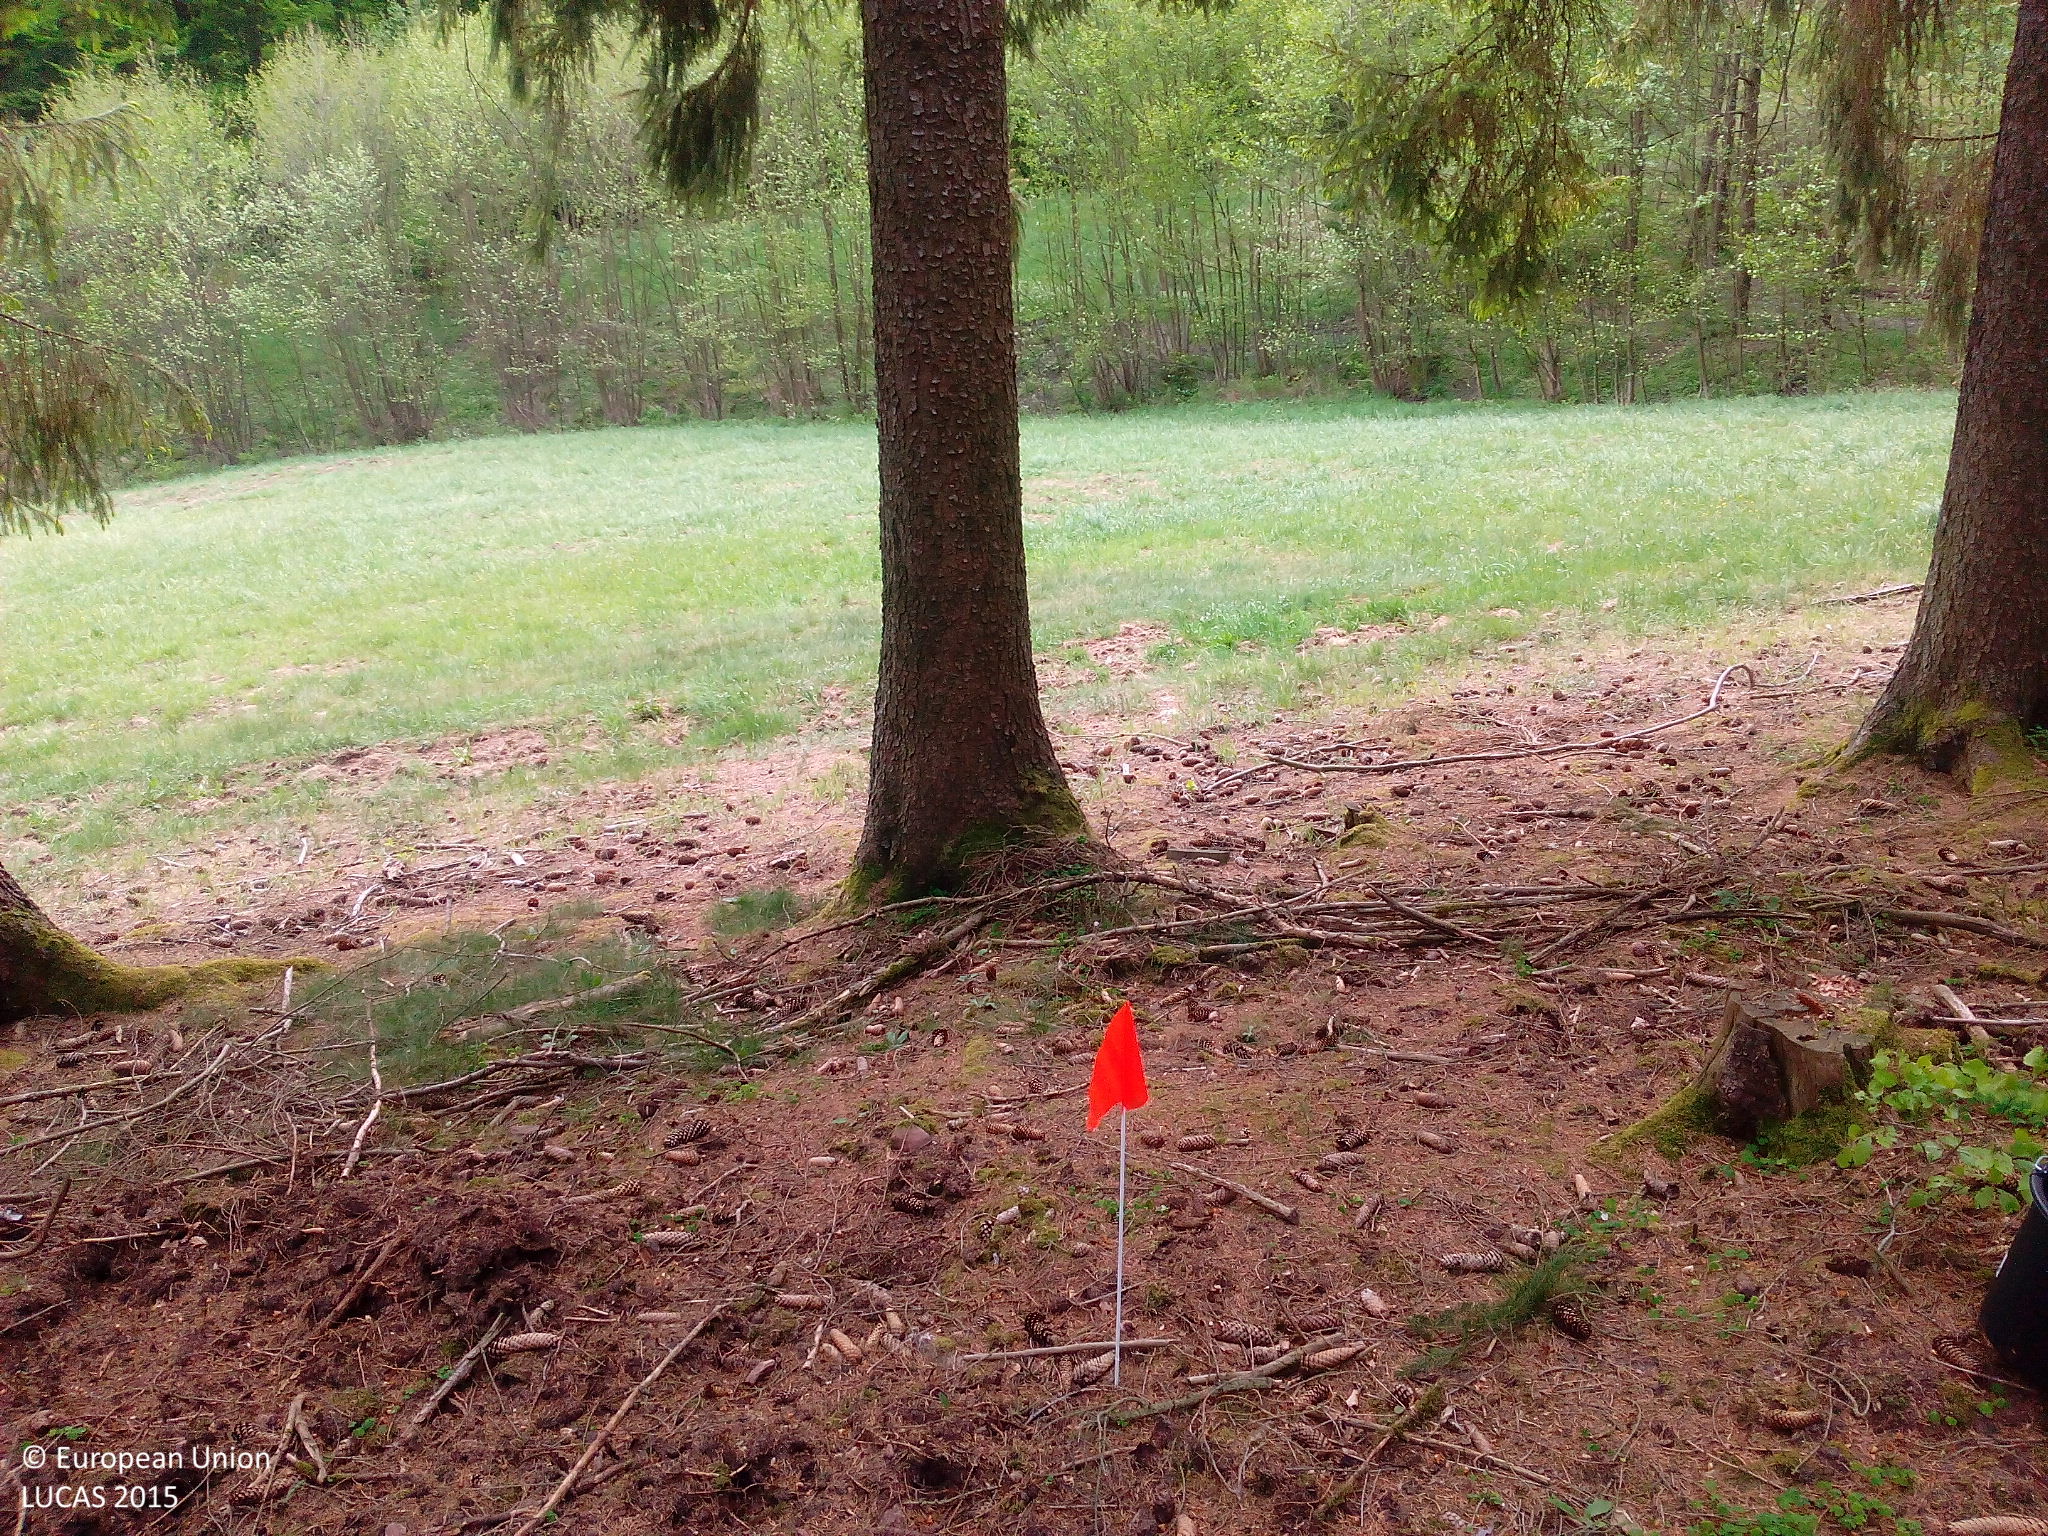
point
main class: Woodland
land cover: Spruce dominated coniferous woodland
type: hemiboreal forest and nemoral coniferous forest and mixed broadleaved-coniferous forest
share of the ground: > 75 %
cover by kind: coniferous forest trees 60 %, unconsolidated bare surface 35 %, lichens and mosses 5 %
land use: Forestry
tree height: > 5 m
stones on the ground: < 10 %
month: May
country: DE
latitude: 51.1910
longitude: 9.8713
